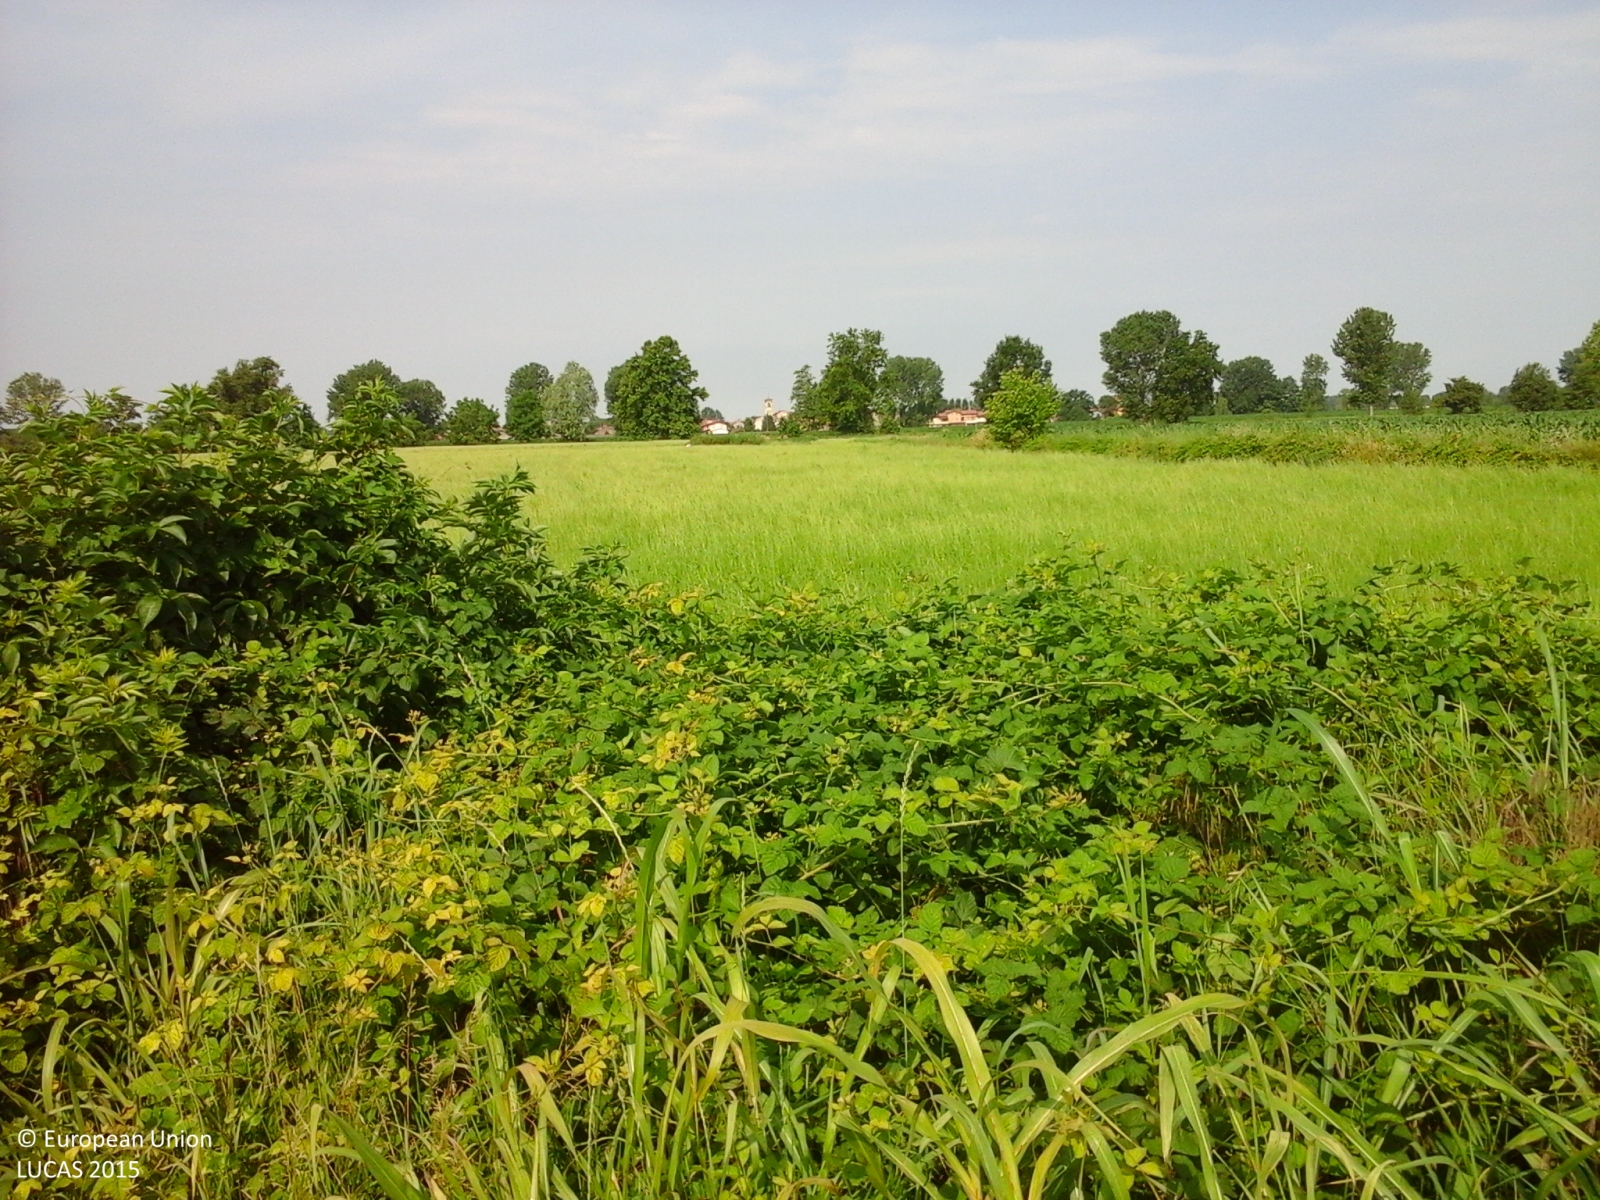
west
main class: Cropland
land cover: Maize
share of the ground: > 75 %
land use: Agriculture (excluding fallow land and kitchen gardens)
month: June
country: IT
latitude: 45.3236
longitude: 9.6562
